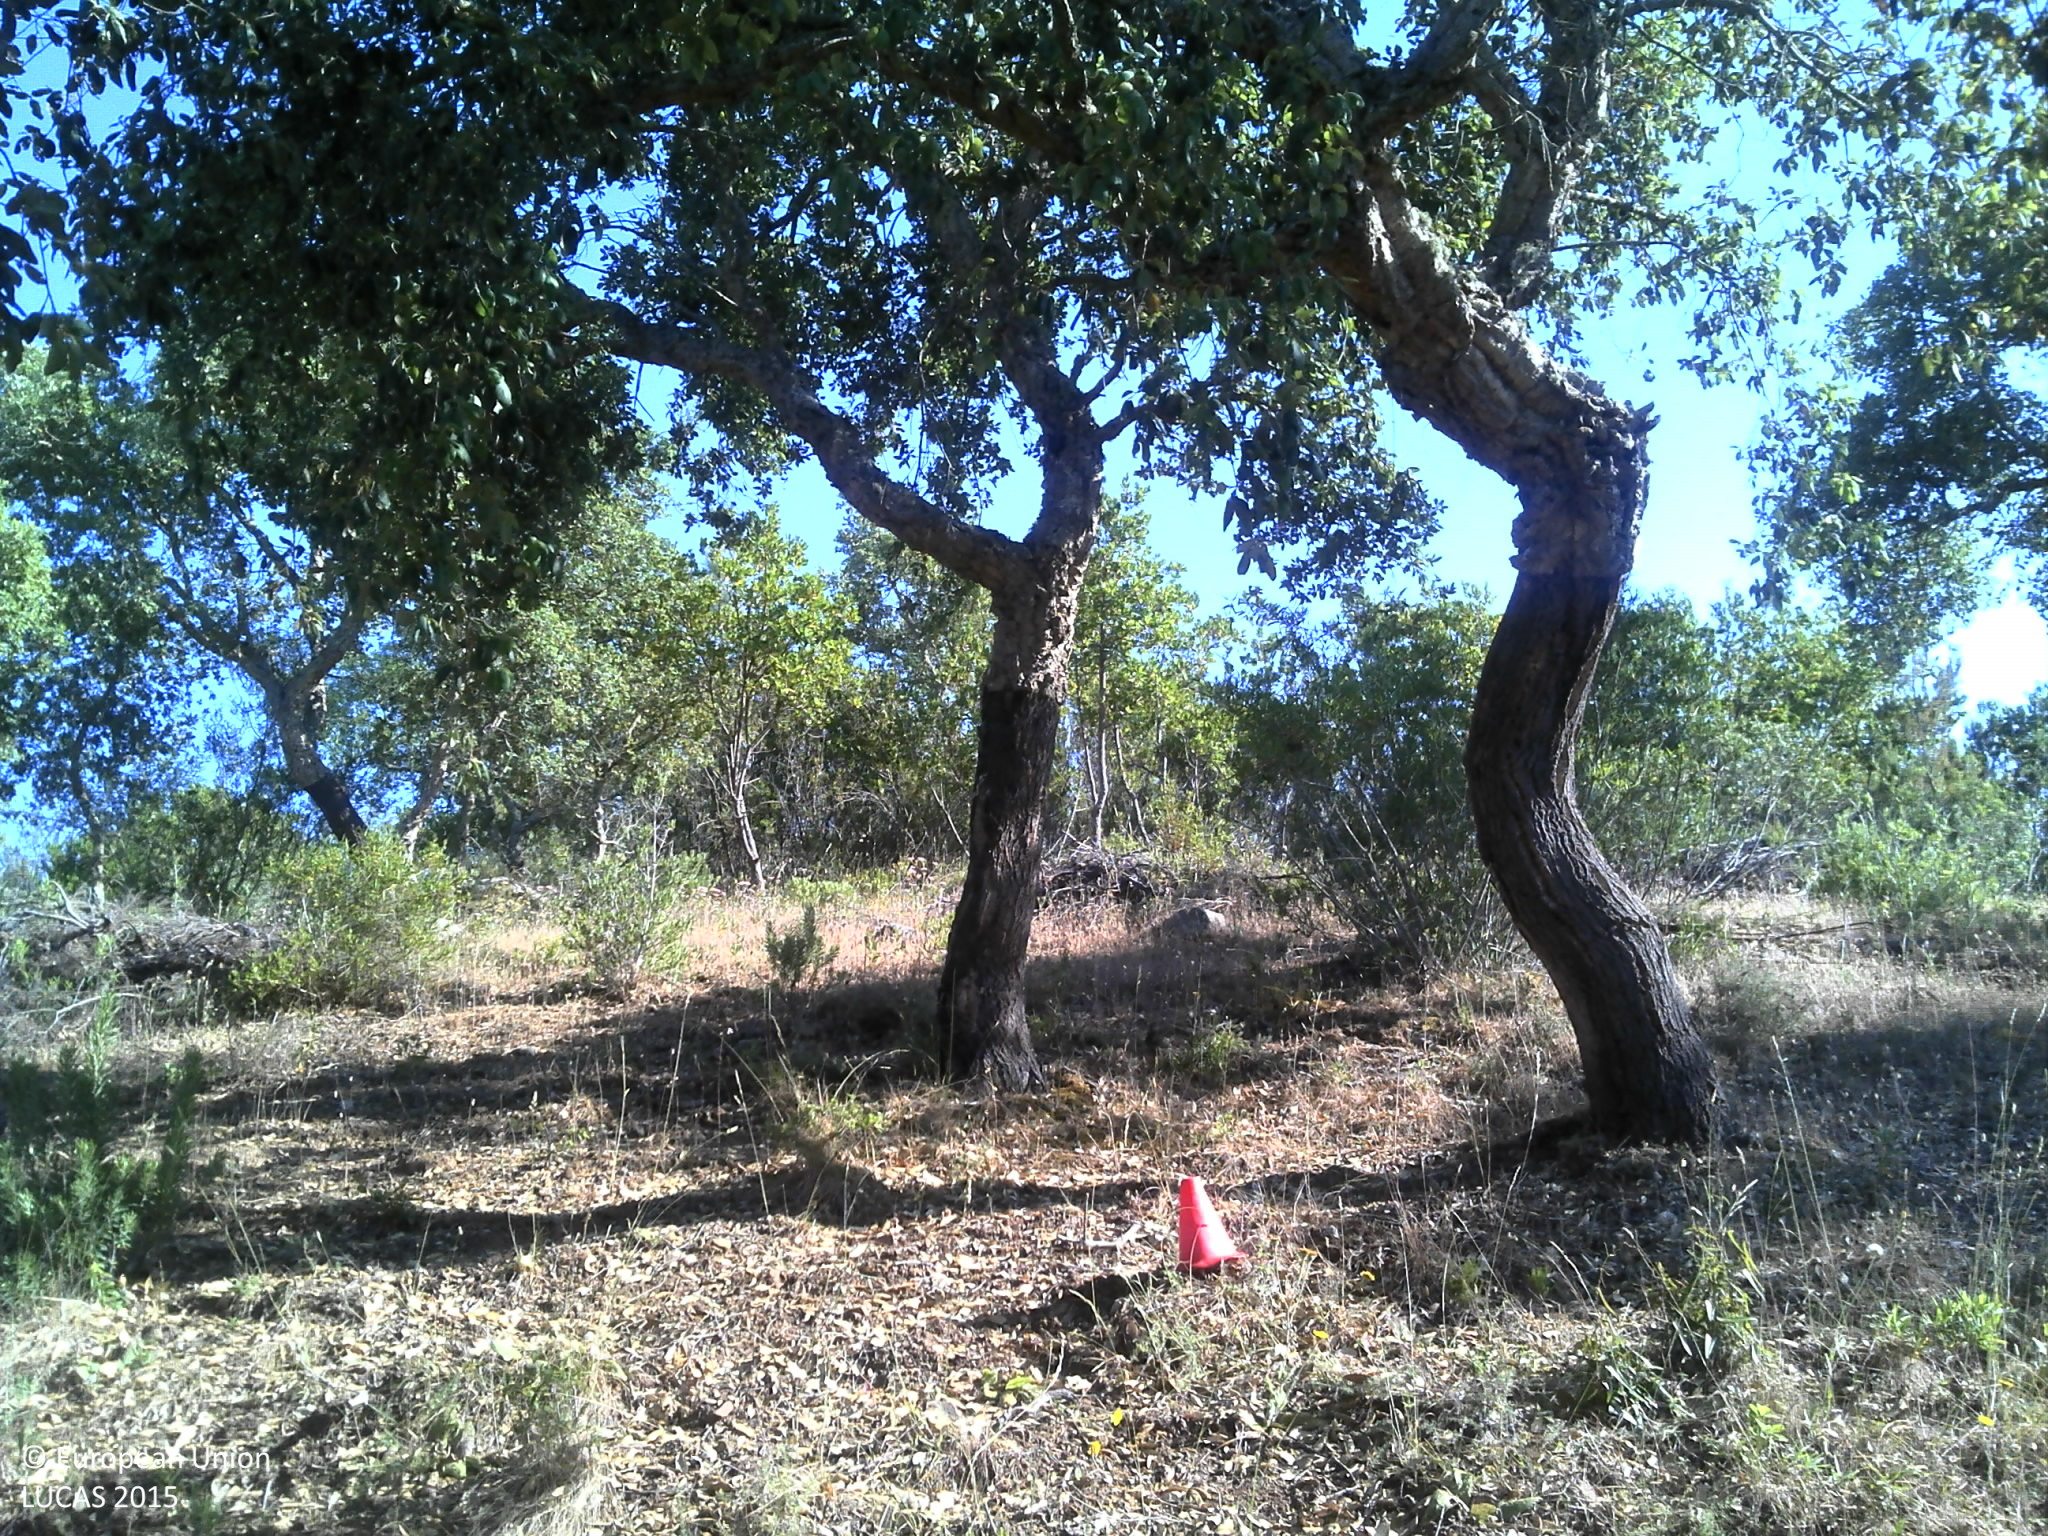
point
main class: Woodland
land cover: Broadleaved woodland
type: broadleaved evergreen forest
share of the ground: 50 - 75 %
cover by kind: broadleaved forest trees 60 %, herbaceous plants 20 %, unconsolidated bare surface 20 %
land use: Forestry
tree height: > 5 m
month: May
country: PT
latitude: 38.1880
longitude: -8.6259
